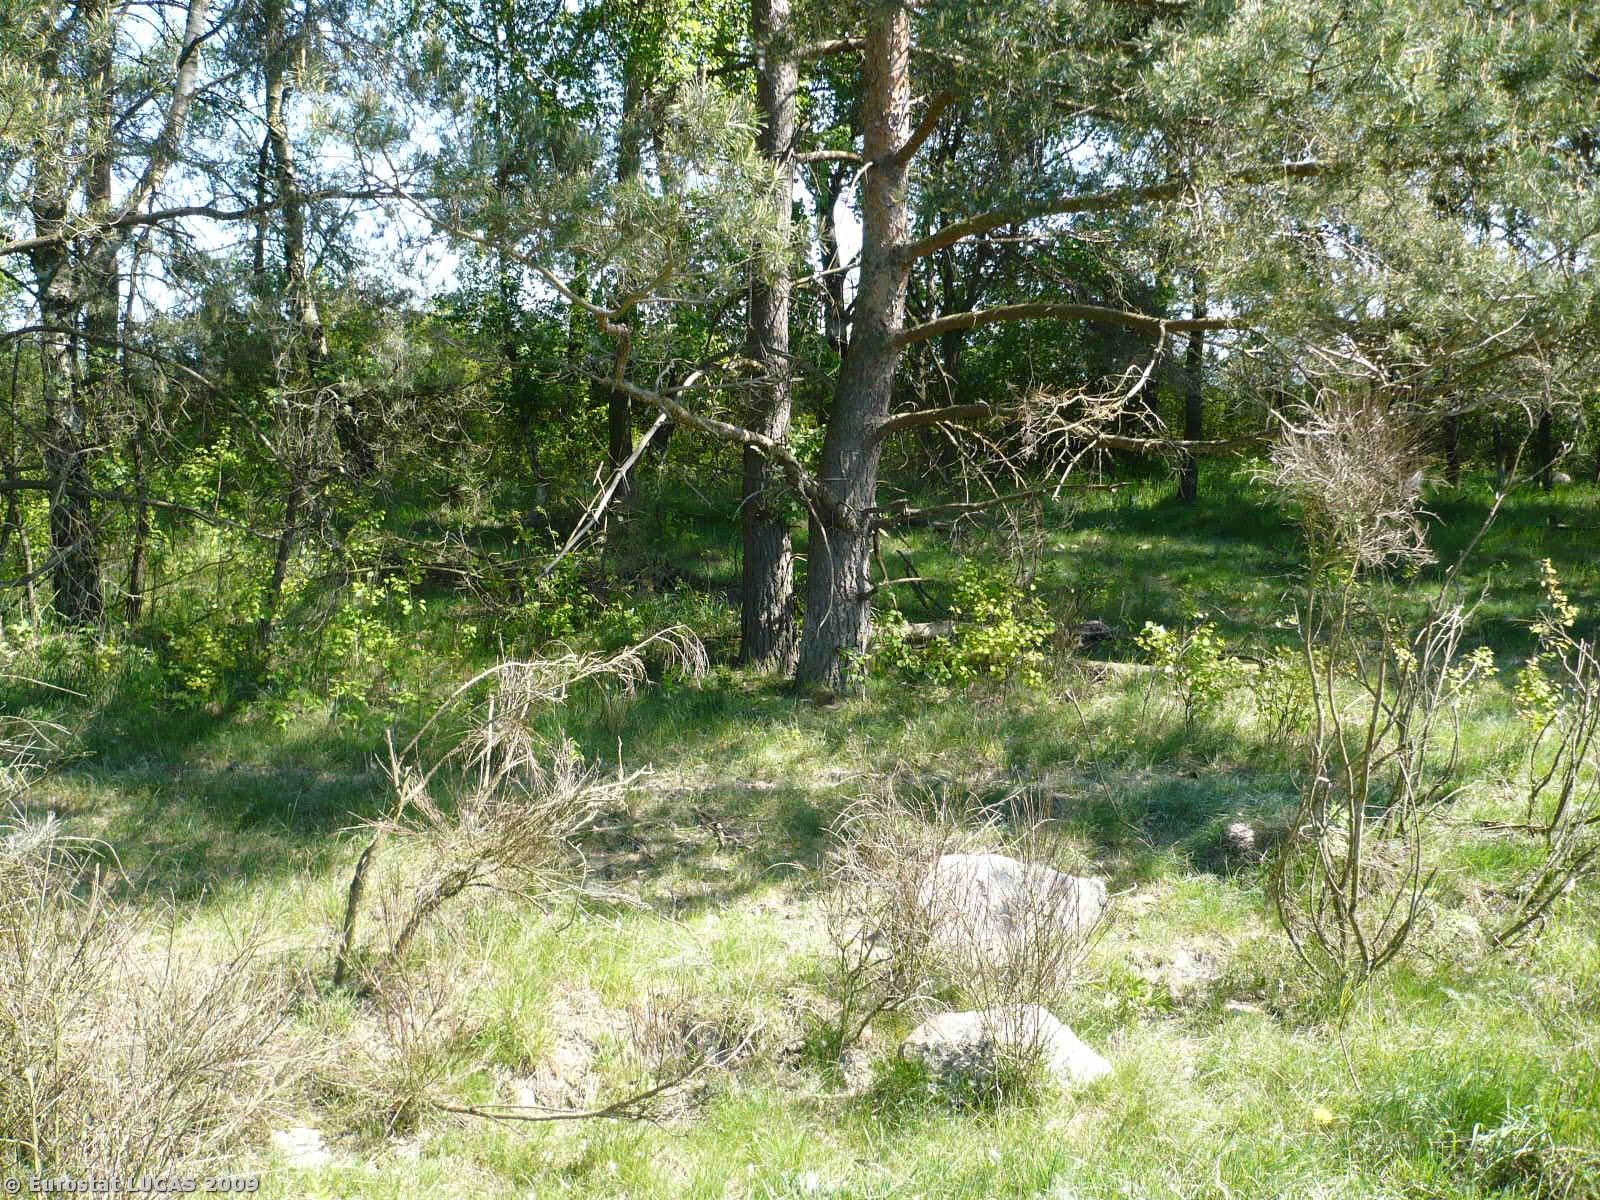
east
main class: Cropland
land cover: Rye
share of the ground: > 75 %
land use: Agriculture (excluding fallow land and kitchen gardens)
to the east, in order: Rye; Coniferous woodland; Shrubland with sparse tree cover; Tracks; Rape and turnip rape
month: May
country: PL
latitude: 52.1689
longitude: 15.6922
